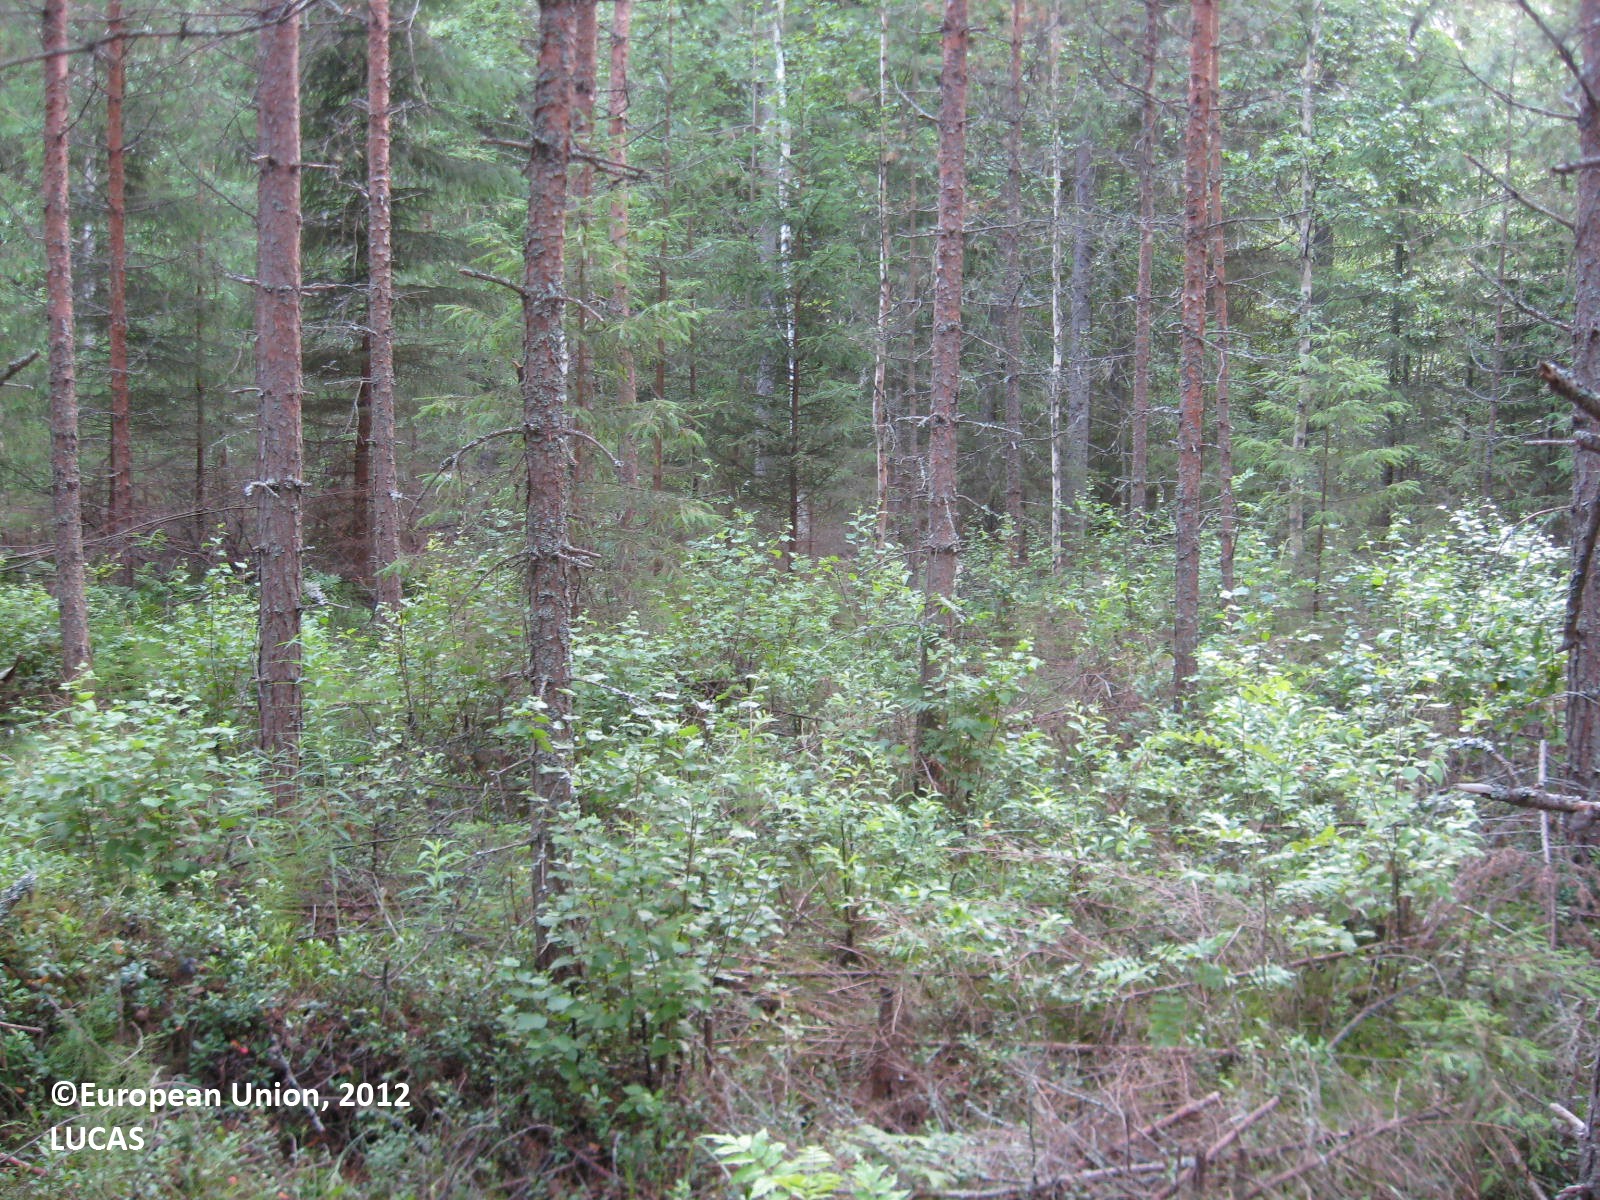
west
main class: Woodland
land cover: Pine dominated coniferous woodland
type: boreal forest
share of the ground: > 75 %
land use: Forestry
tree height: > 5 m
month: July
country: FI
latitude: 62.5893
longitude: 21.5111
